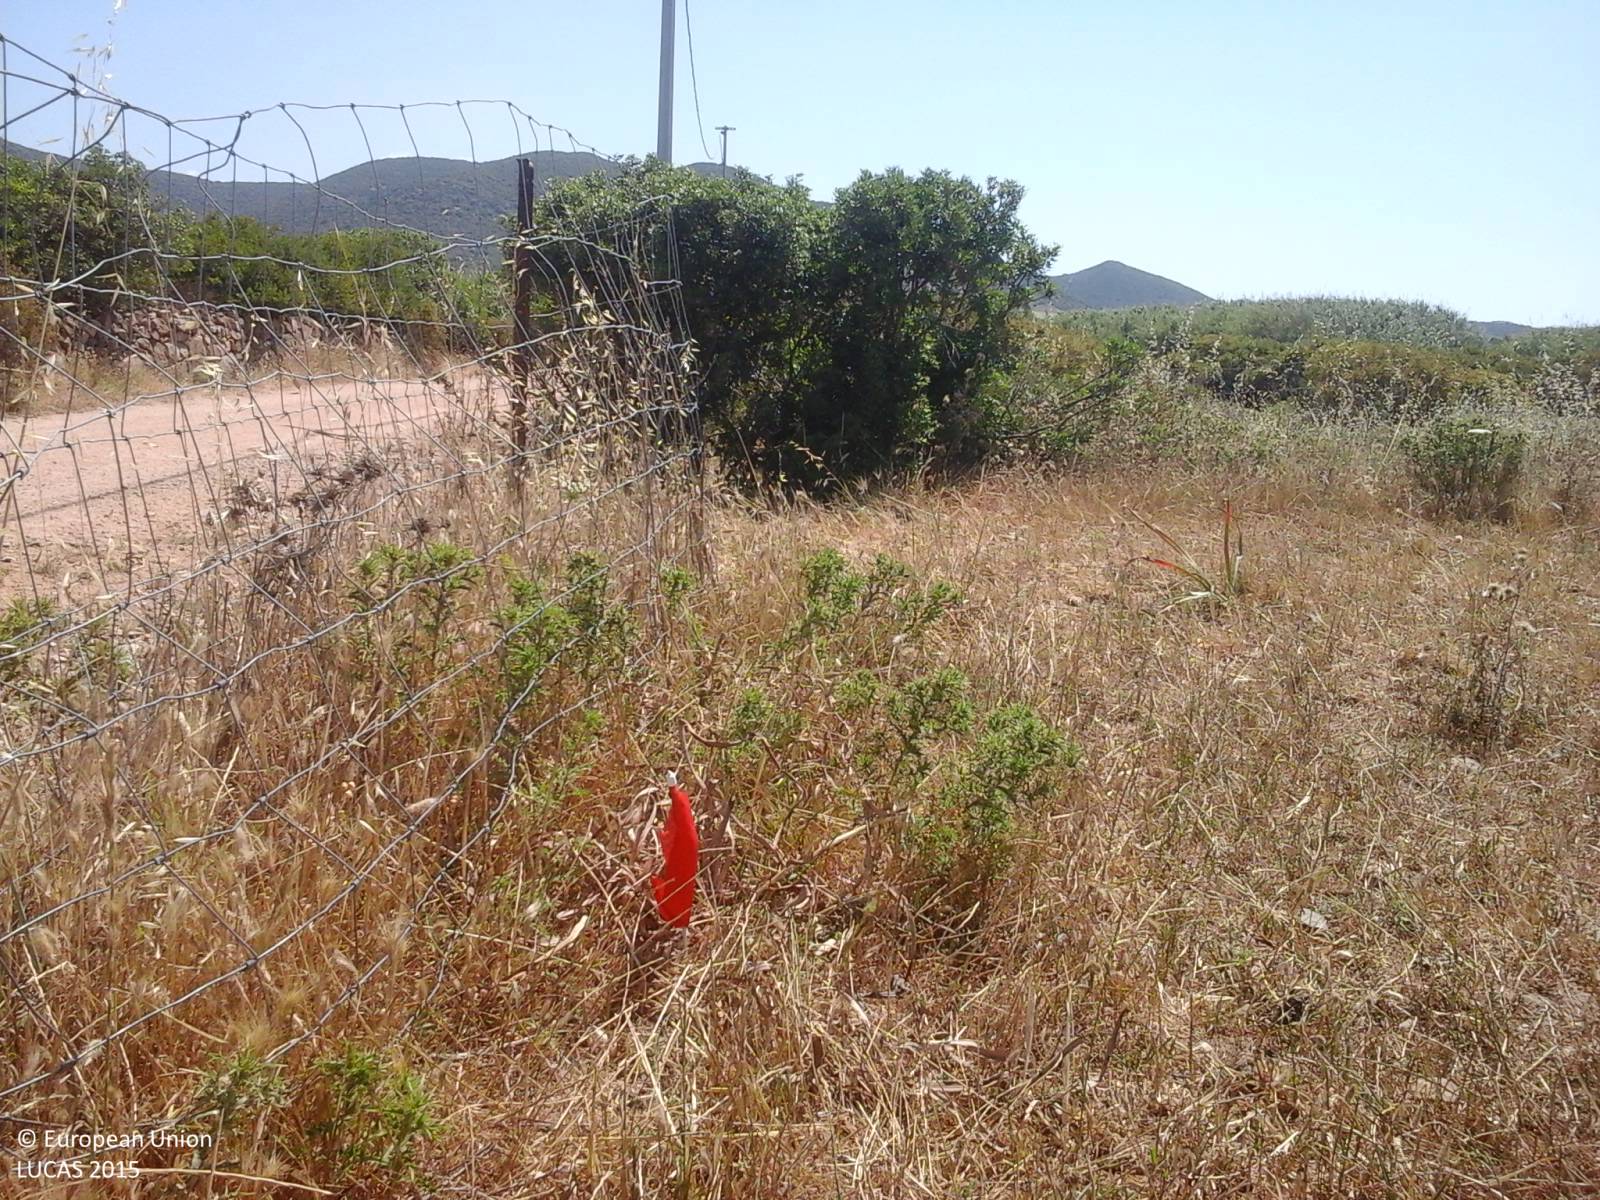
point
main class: Shrubland
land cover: Shrubland without tree cover
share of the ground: > 75 %
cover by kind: herbaceous plants 60 %, consolidated bare surface 25 %, shrubs 15 %
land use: Agriculture (excluding fallow land and kitchen gardens)
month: June
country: IT
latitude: 38.9903
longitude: 8.6808
